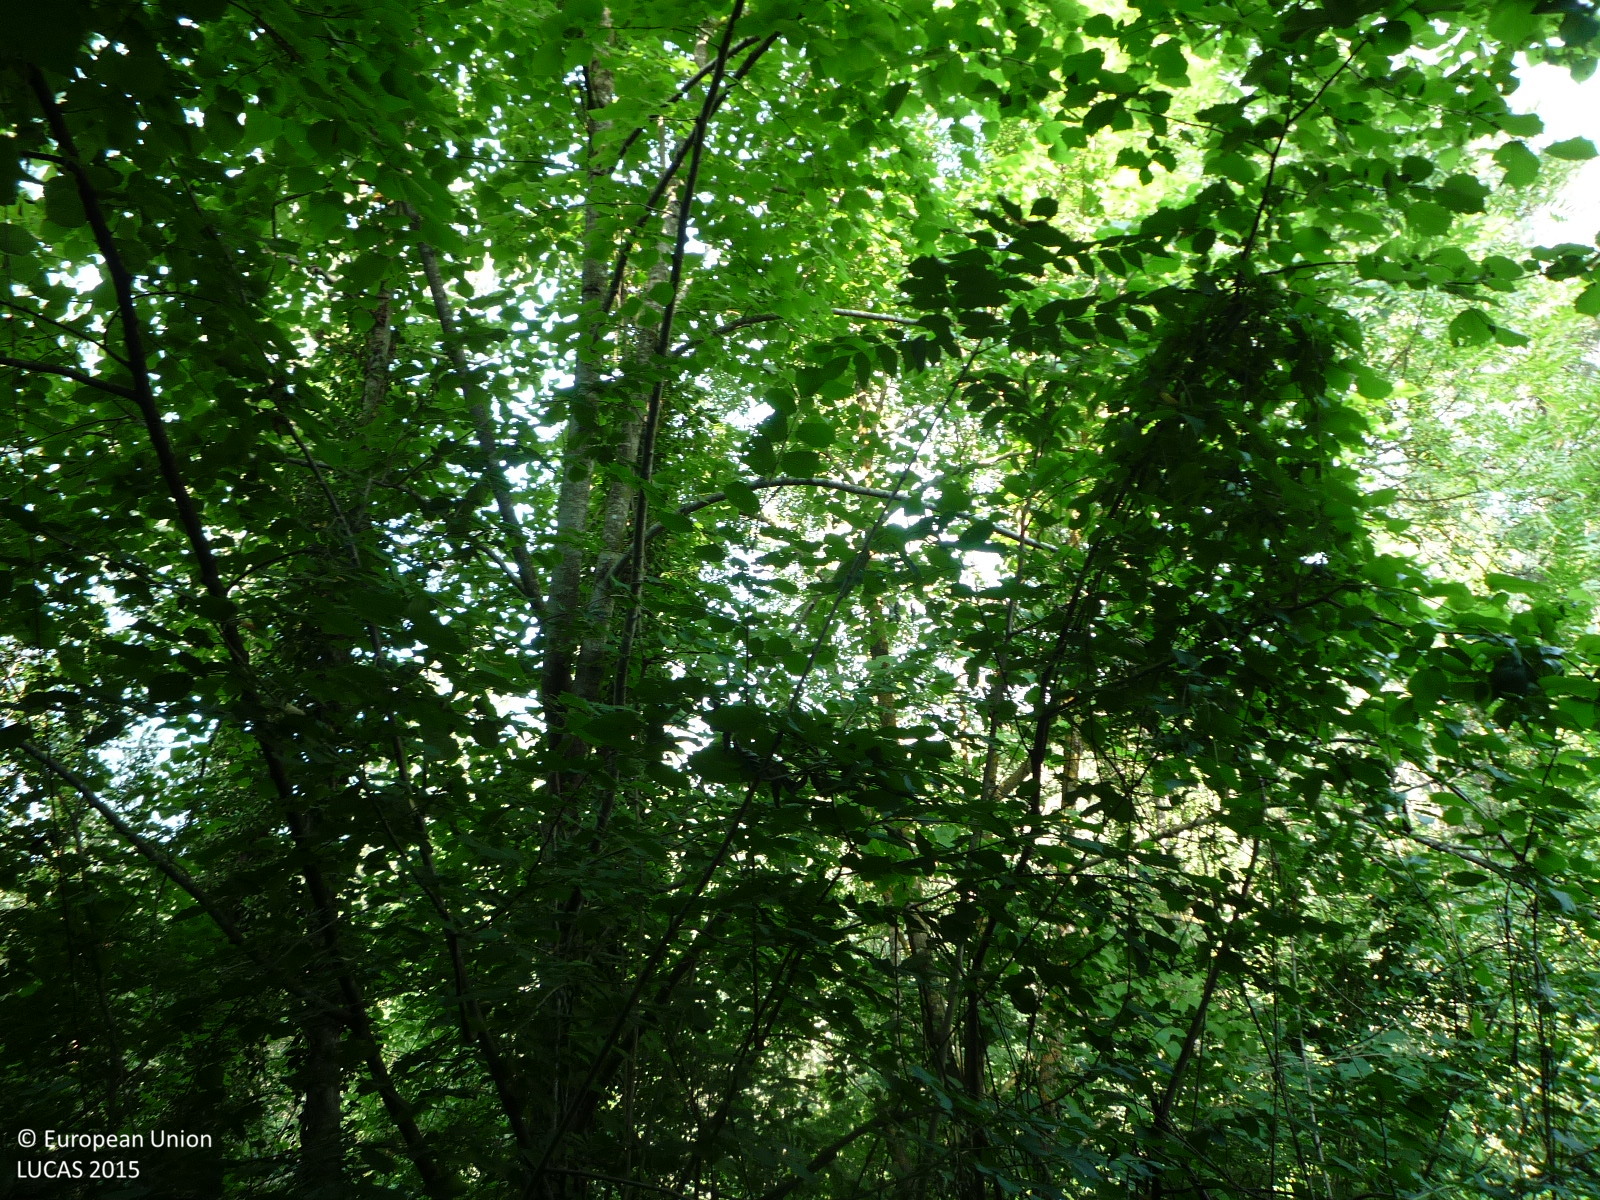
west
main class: Woodland
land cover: Other mixed woodland
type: thermophilous deciduous forest
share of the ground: > 75 %
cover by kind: broadleaved forest trees 75 %, coniferous forest trees 25 %
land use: Forestry
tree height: > 5 m
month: July
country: ES
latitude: 42.1312
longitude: 1.9196
